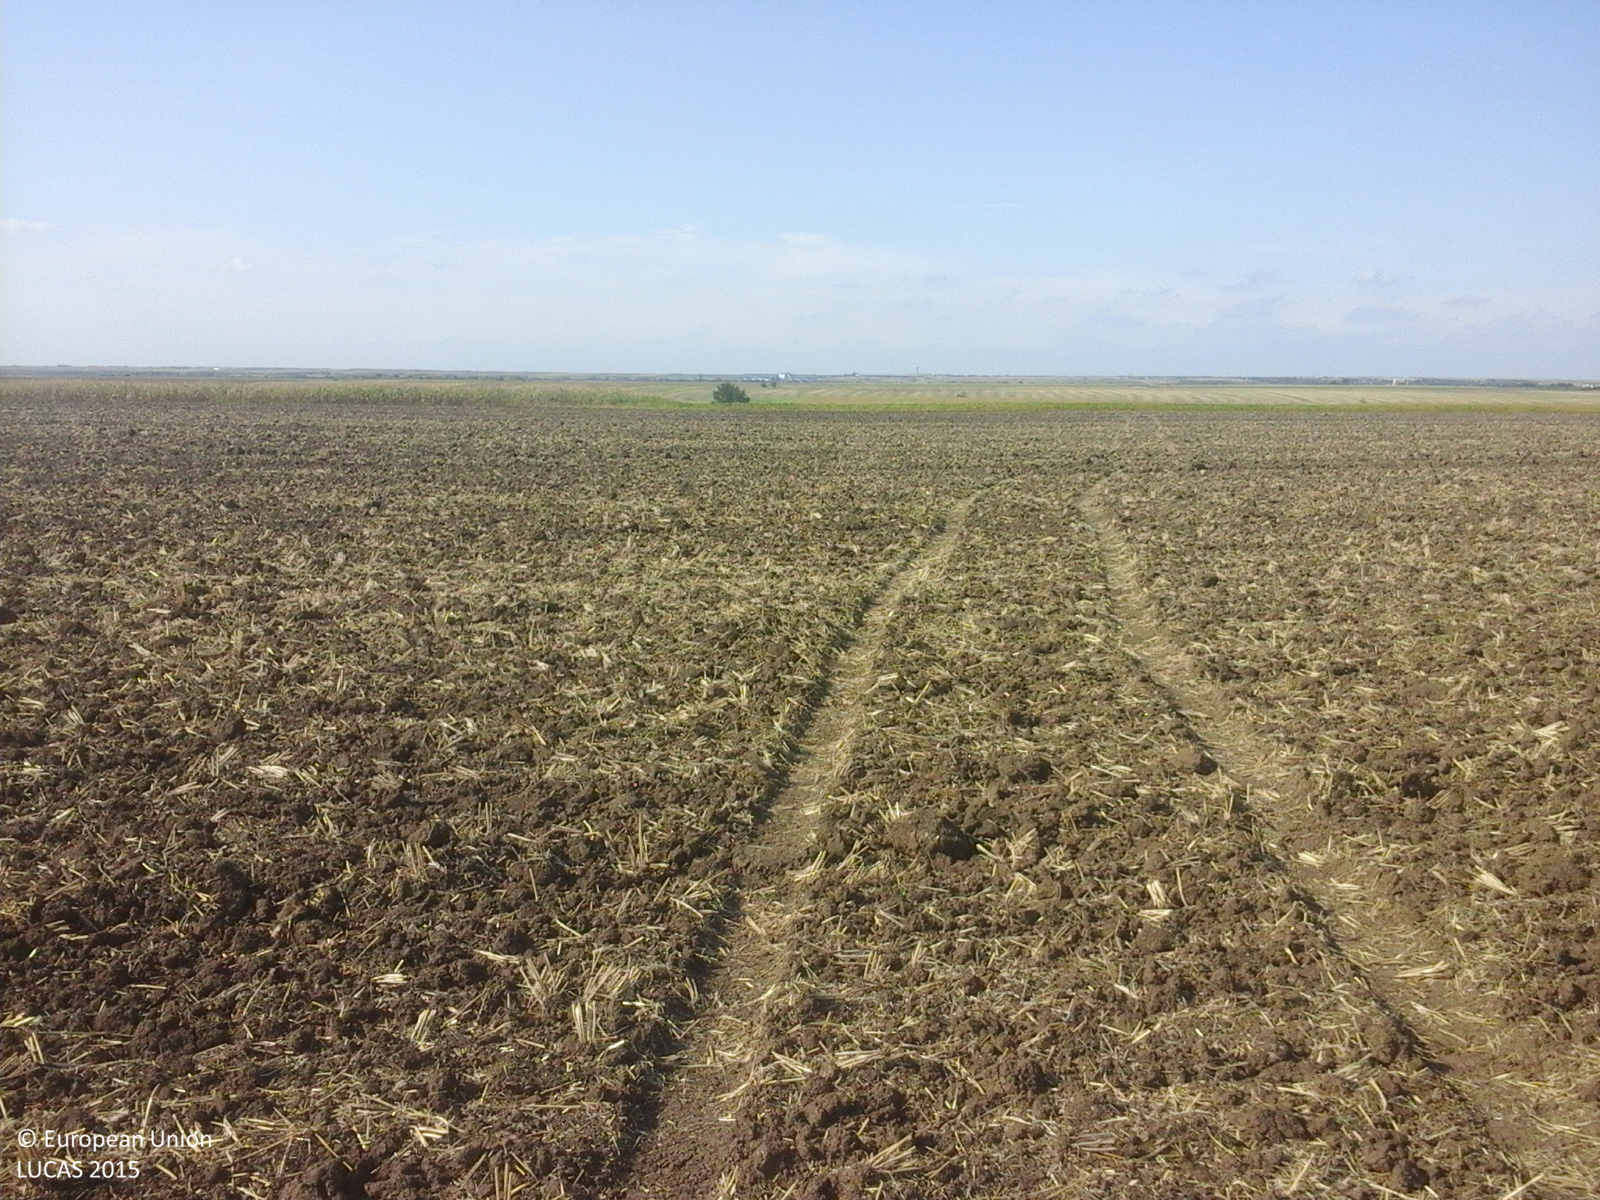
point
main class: Cropland
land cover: Common wheat
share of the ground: < 10 %
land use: Agriculture (excluding fallow land and kitchen gardens)
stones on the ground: < 10 %
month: August
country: RO
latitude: 45.3928
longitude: 21.4117
